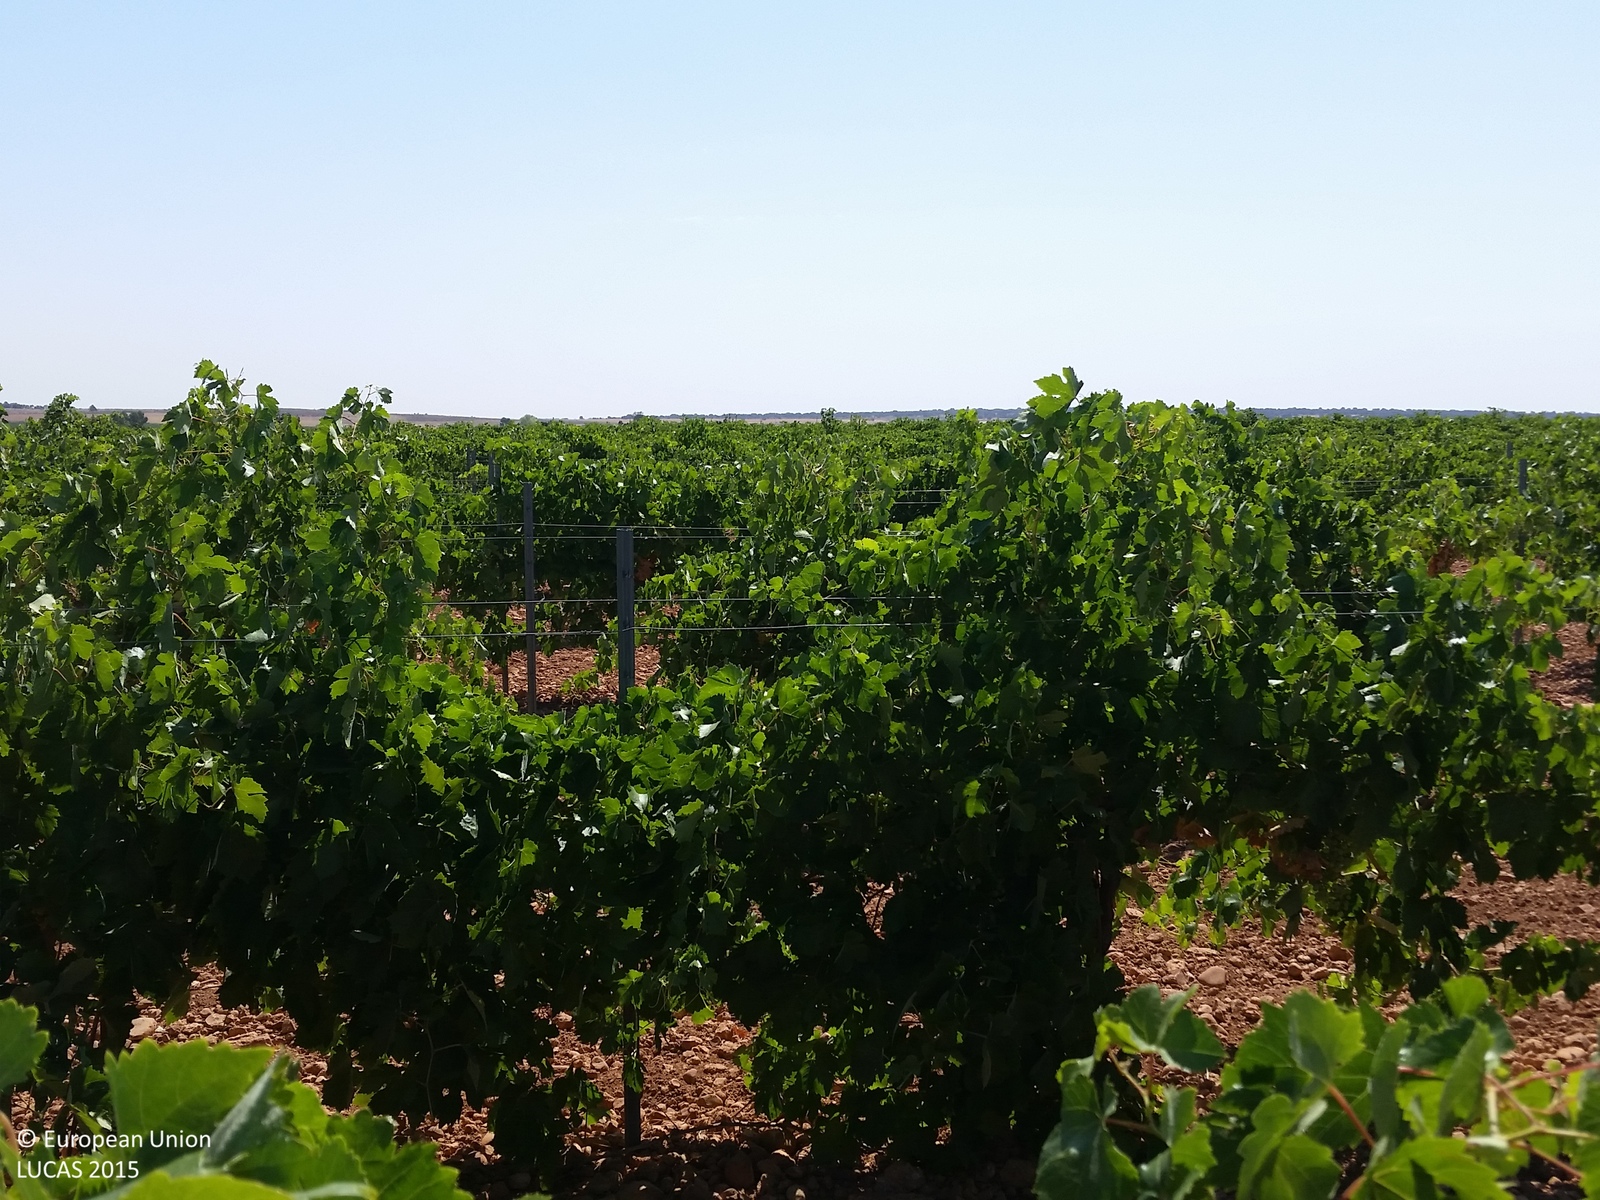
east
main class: Cropland
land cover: Vineyards
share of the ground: 50 - 75 %
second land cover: Other bare soil
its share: > 75 %
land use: Agriculture (excluding fallow land and kitchen gardens)
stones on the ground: 10 - 25 %
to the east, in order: Vineyards; Other bare soil
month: July
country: ES
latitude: 39.2168
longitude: -2.5758
